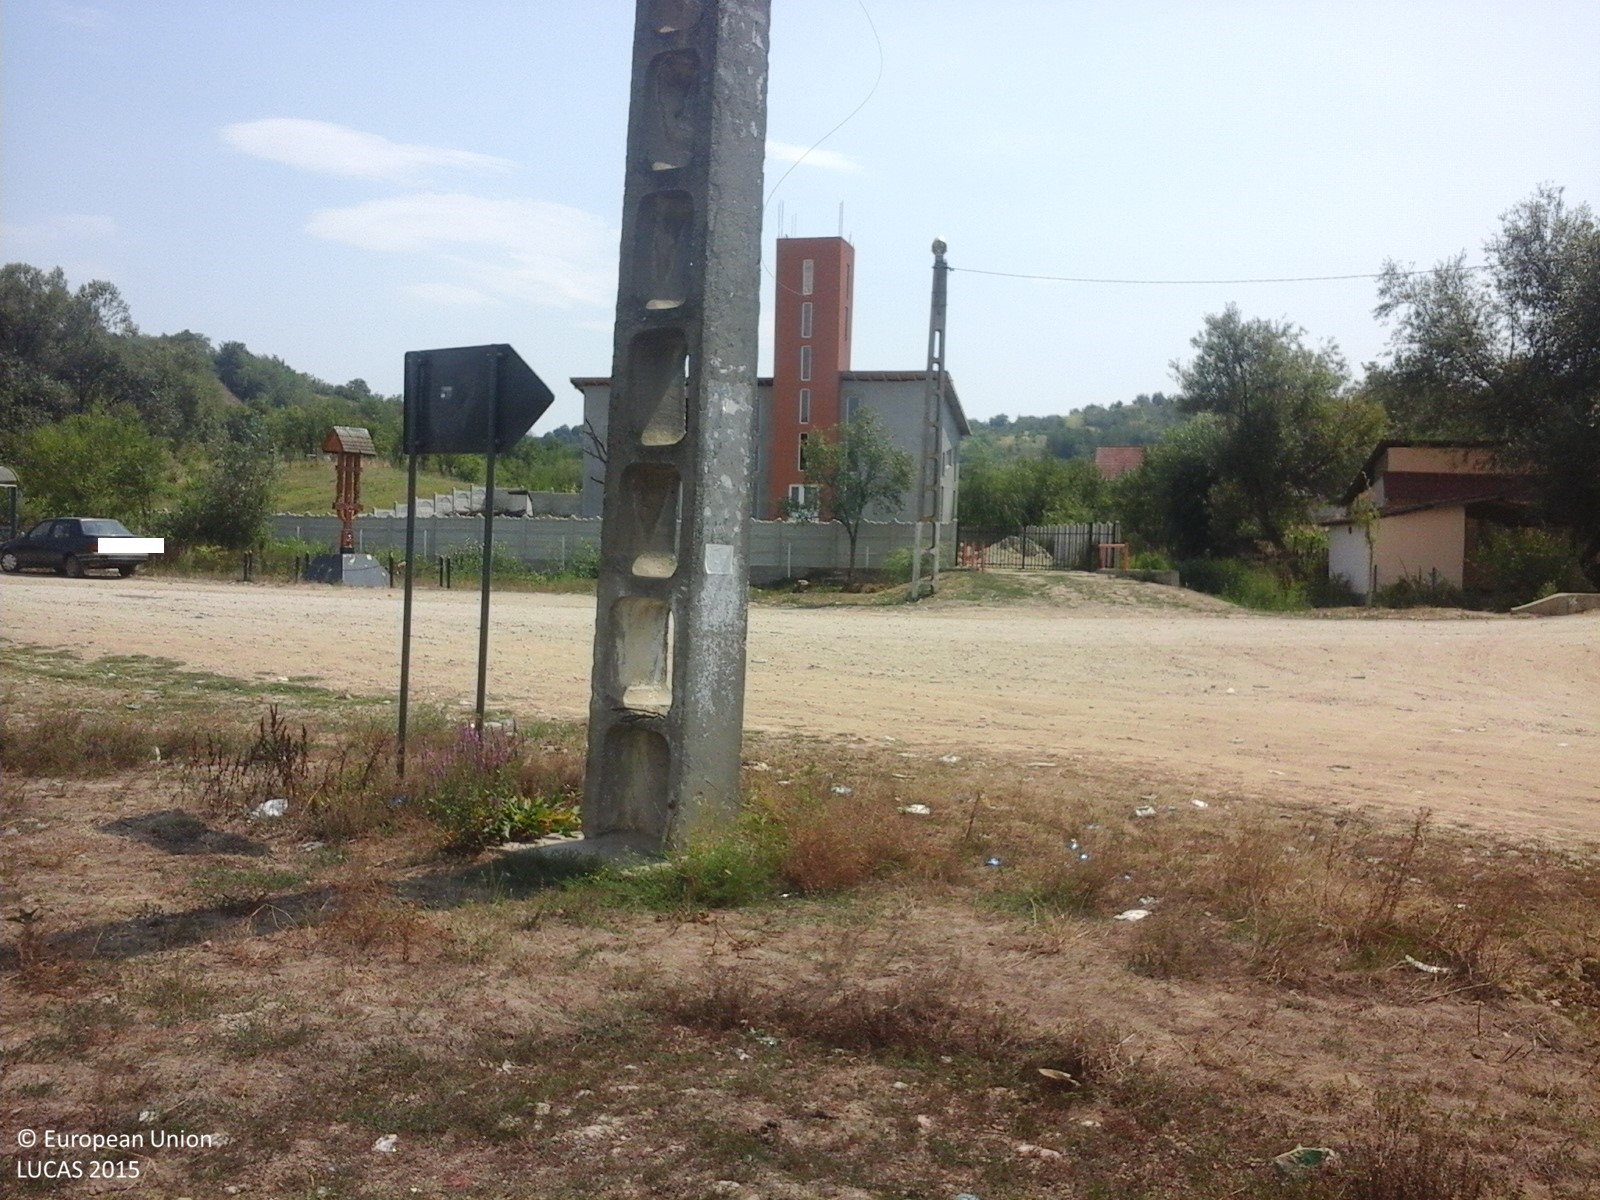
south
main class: Grassland
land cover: Spontaneously vegetated surfaces
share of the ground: > 75 %
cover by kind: herbaceous plants 100 %
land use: Residential
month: August
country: RO
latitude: 44.5869
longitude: 23.5704
